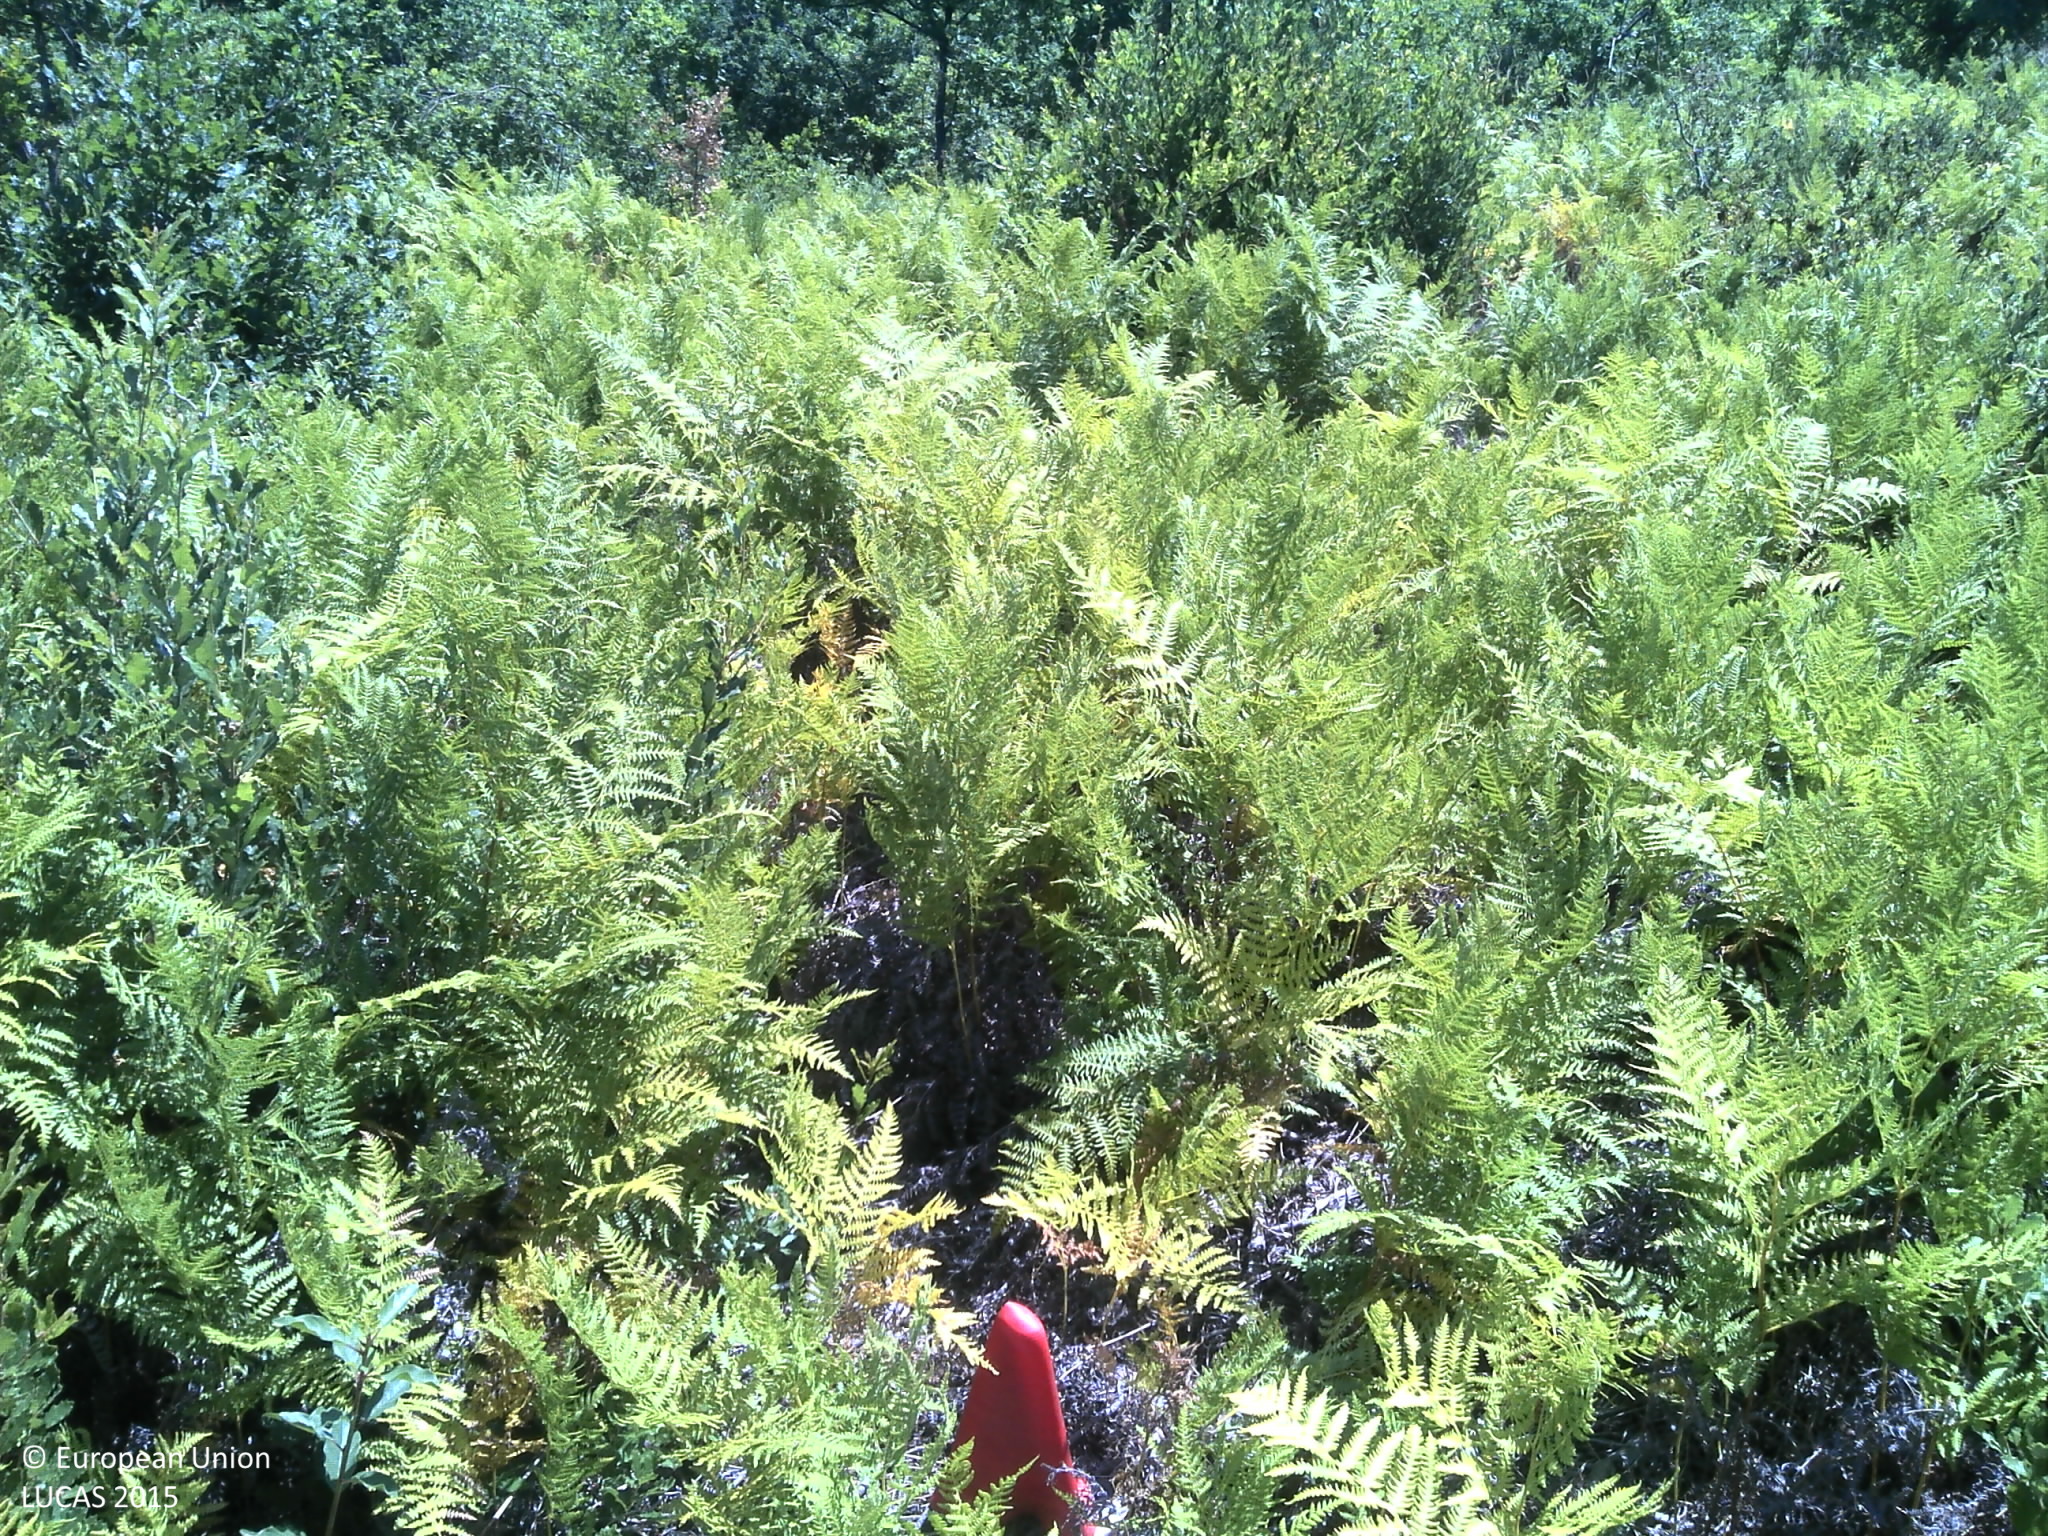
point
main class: Grassland
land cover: Grassland with sparse tree/shrub cover
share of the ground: > 75 %
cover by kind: herbaceous plants 50 %, unconsolidated bare surface 40 %, broadleaved forest trees 5 %, shrubs 5 %
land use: Forestry
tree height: < 5 m
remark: Clear cut
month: July
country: PT
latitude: 40.2717
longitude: -7.9829
